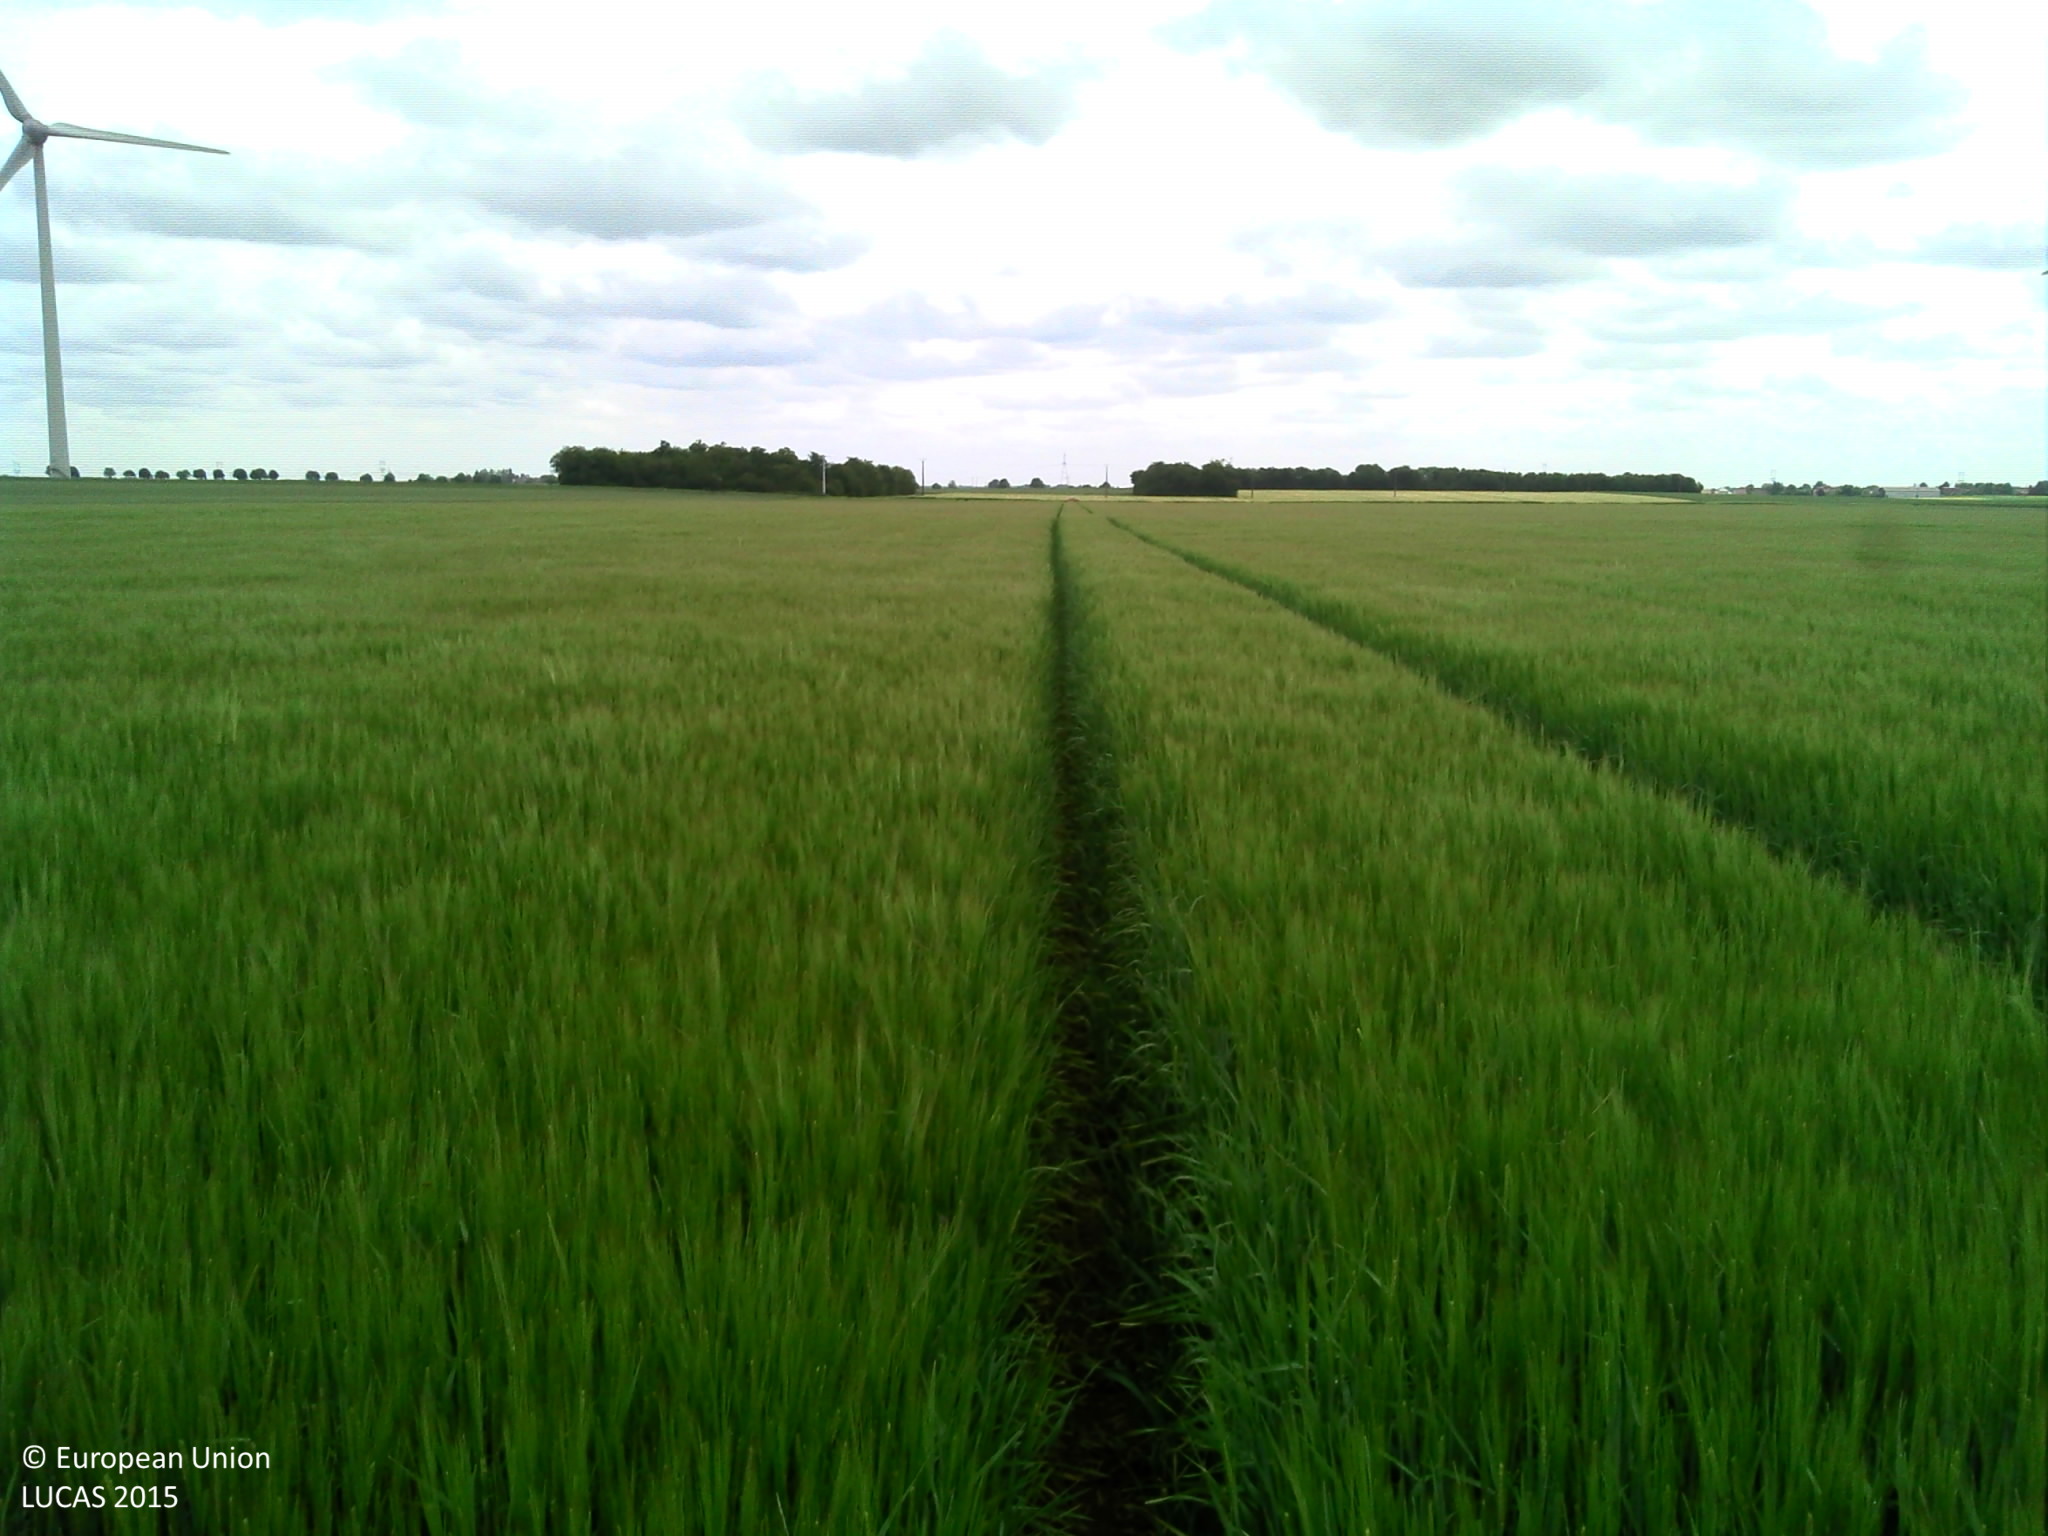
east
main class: Cropland
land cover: Barley
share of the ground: > 75 %
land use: Agriculture (excluding fallow land and kitchen gardens)
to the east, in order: Barley
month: June
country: FR
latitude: 48.3811
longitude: 1.9527
